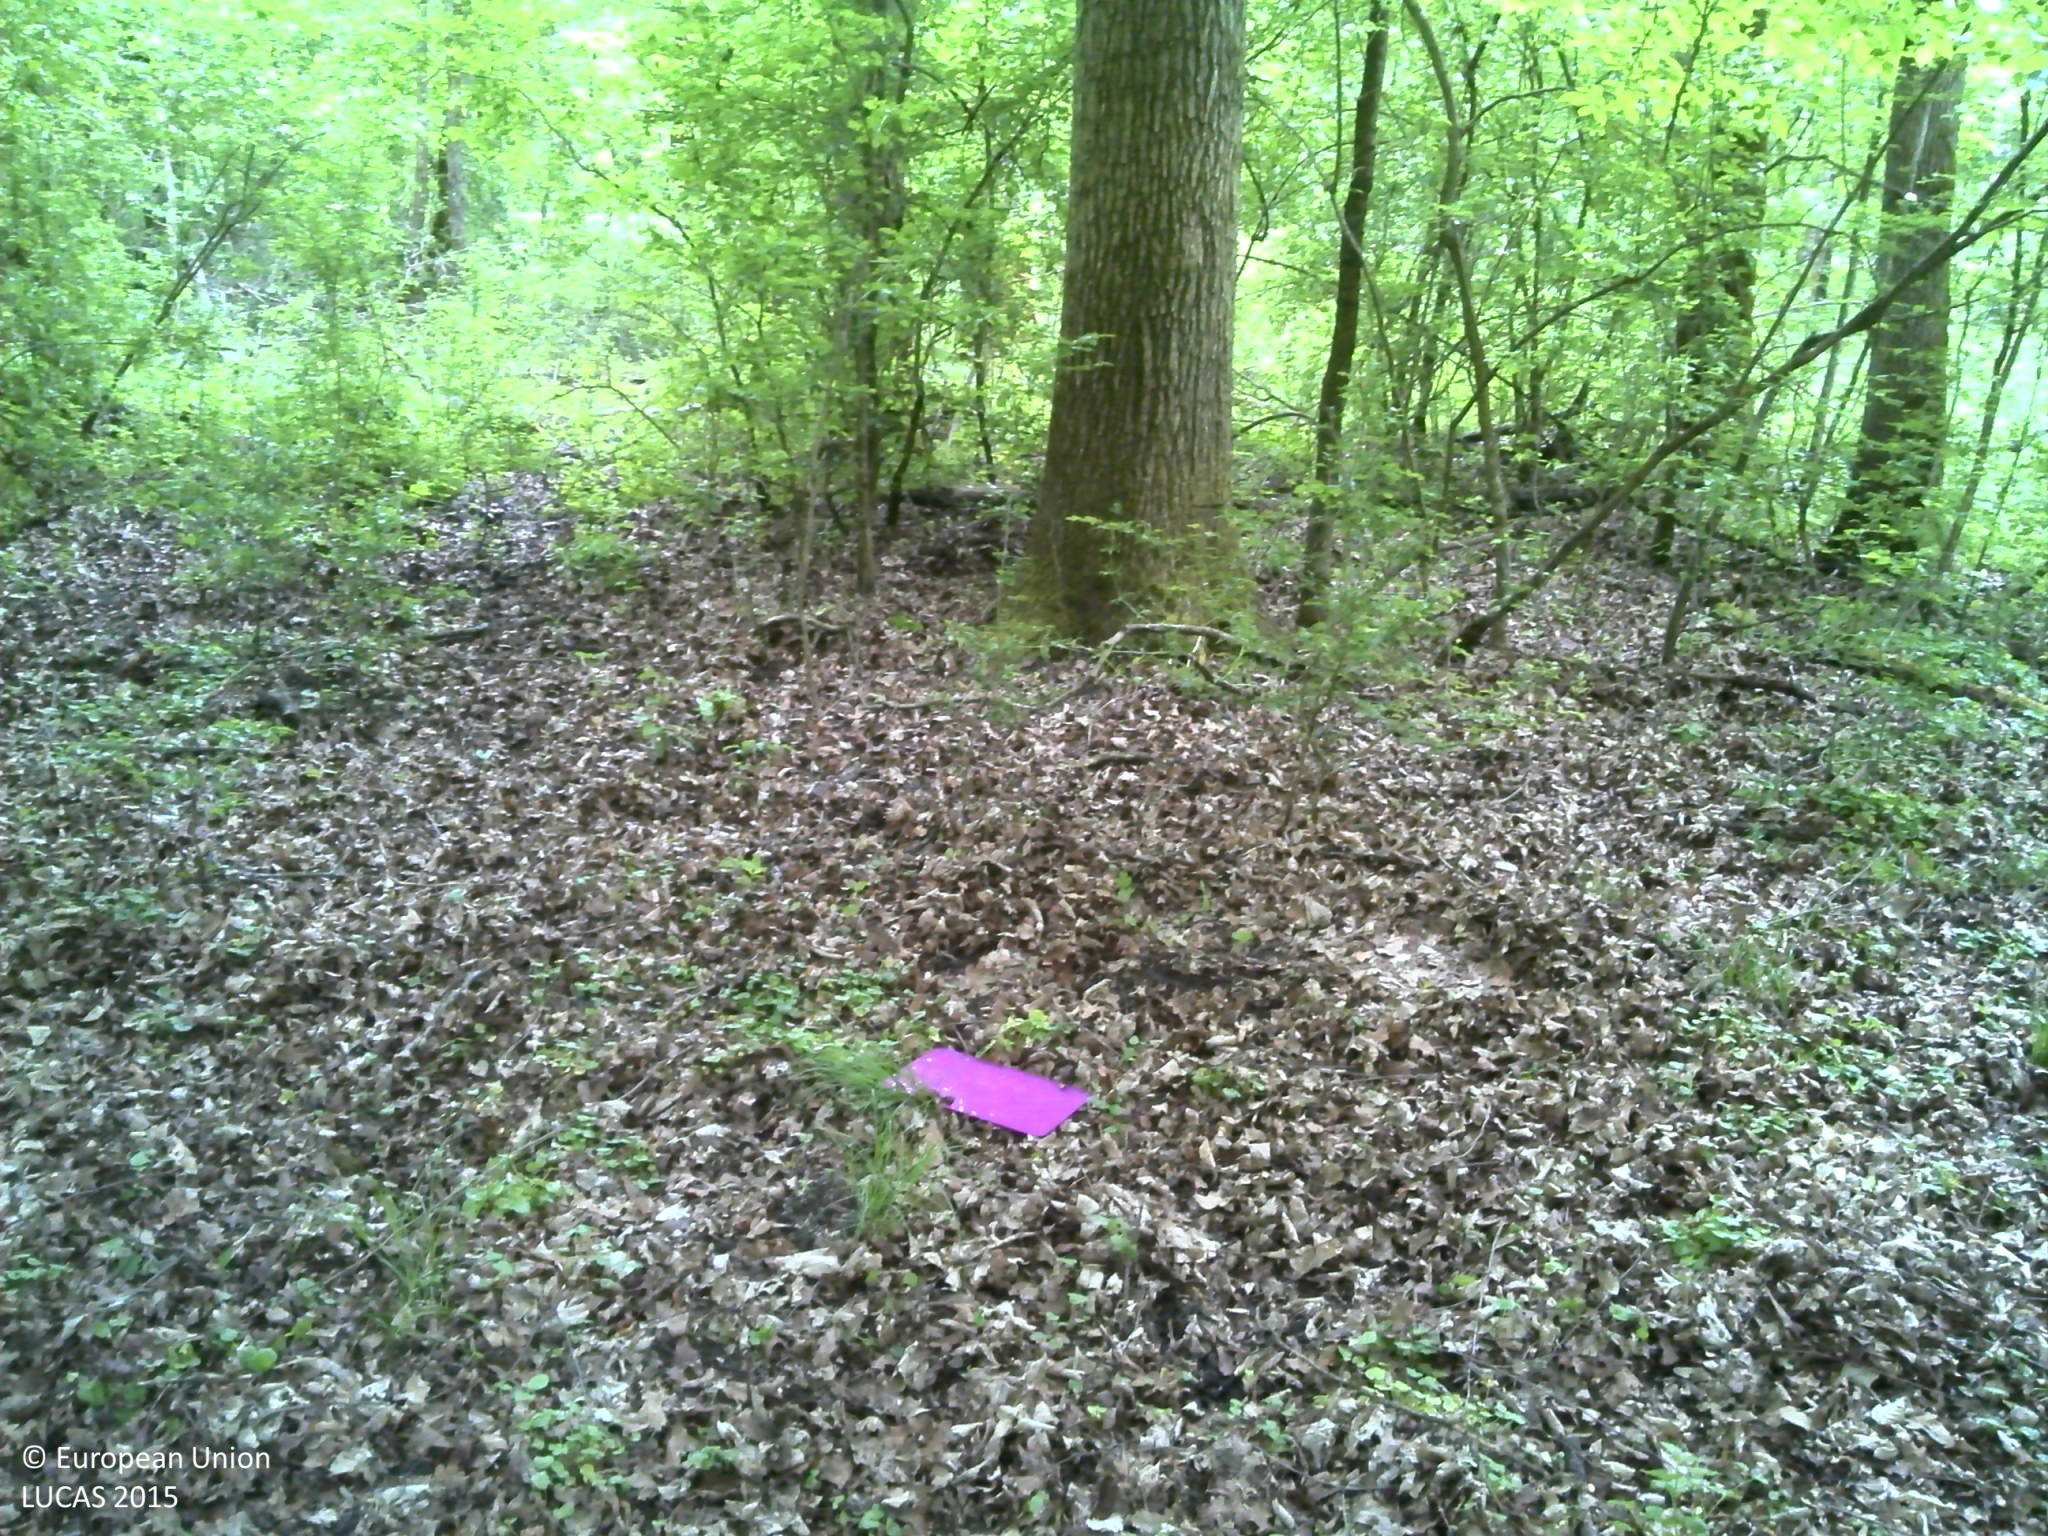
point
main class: Woodland
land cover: Broadleaved woodland
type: mesophytic deciduous forest
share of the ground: > 75 %
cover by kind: broadleaved forest trees 100 %
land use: Forestry
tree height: > 5 m
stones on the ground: < 10 %
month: April
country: HR
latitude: 45.0103
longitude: 19.0031
